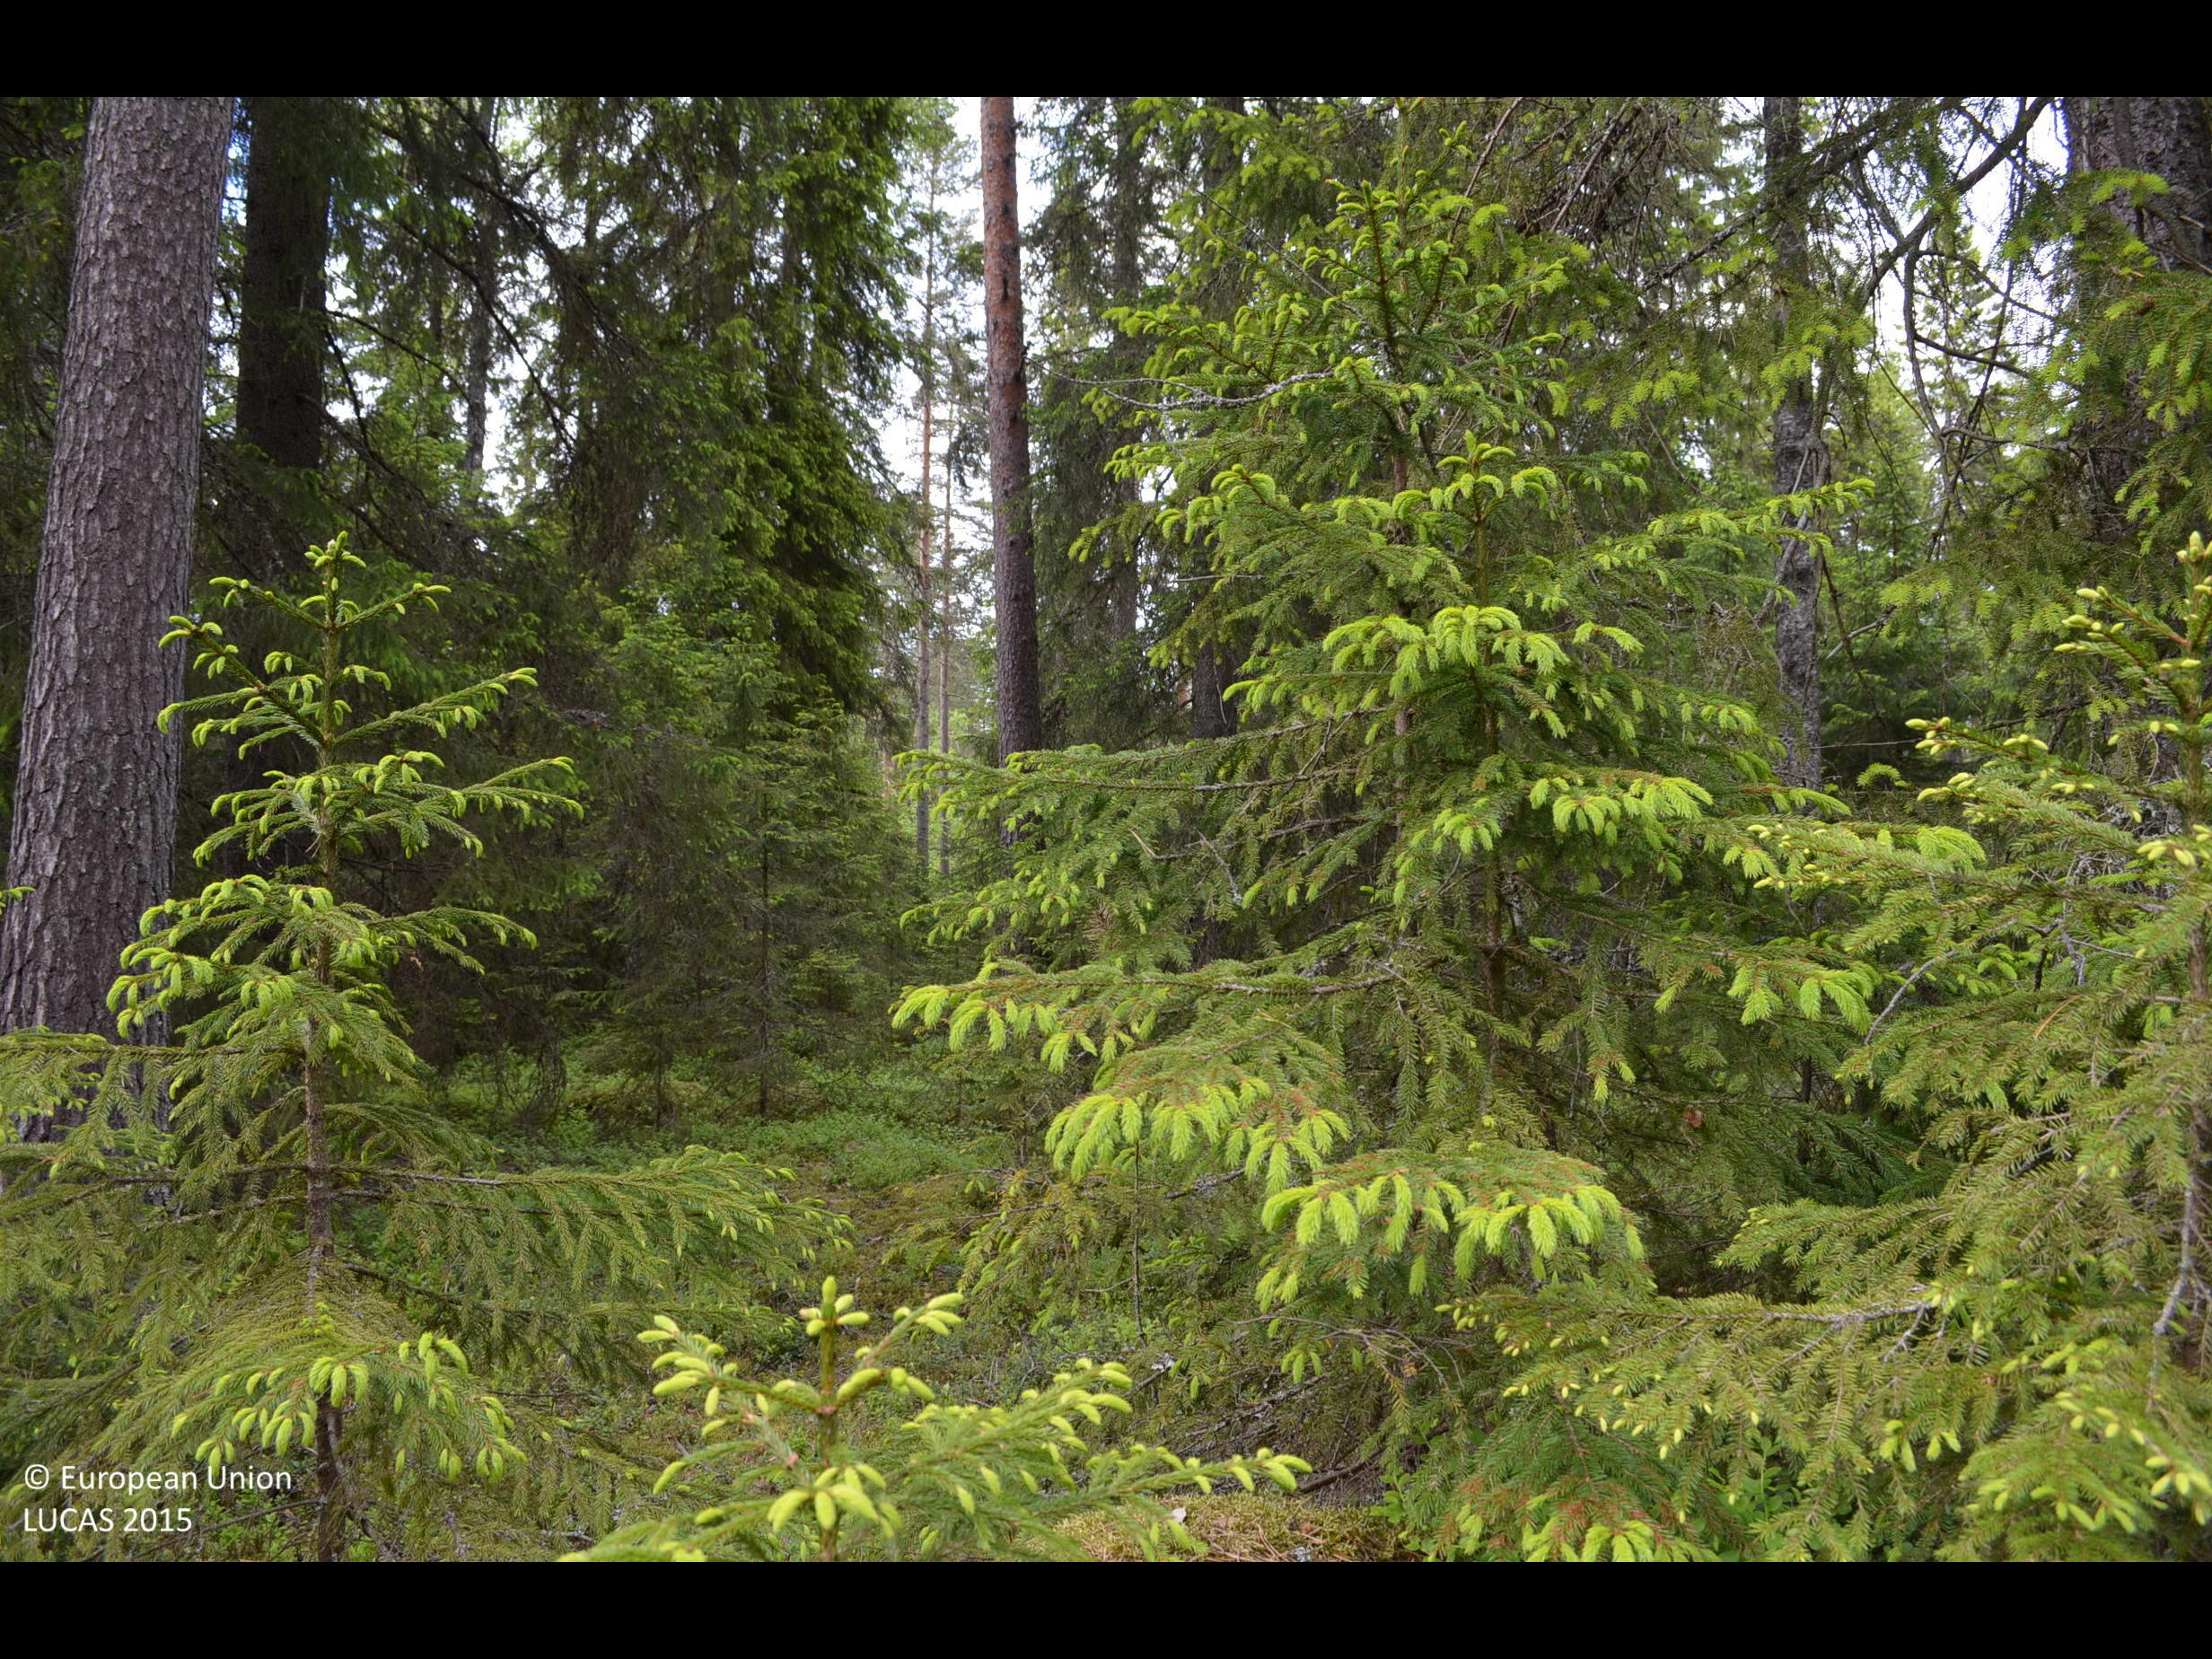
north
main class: Woodland
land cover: Other coniferous woodland
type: boreal forest
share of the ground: > 75 %
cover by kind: coniferous forest trees 65 %, shrubs 20 %, broadleaved forest trees 15 %
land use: Community services
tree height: > 5 m
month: June
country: FI
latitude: 61.9406
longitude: 23.3559
